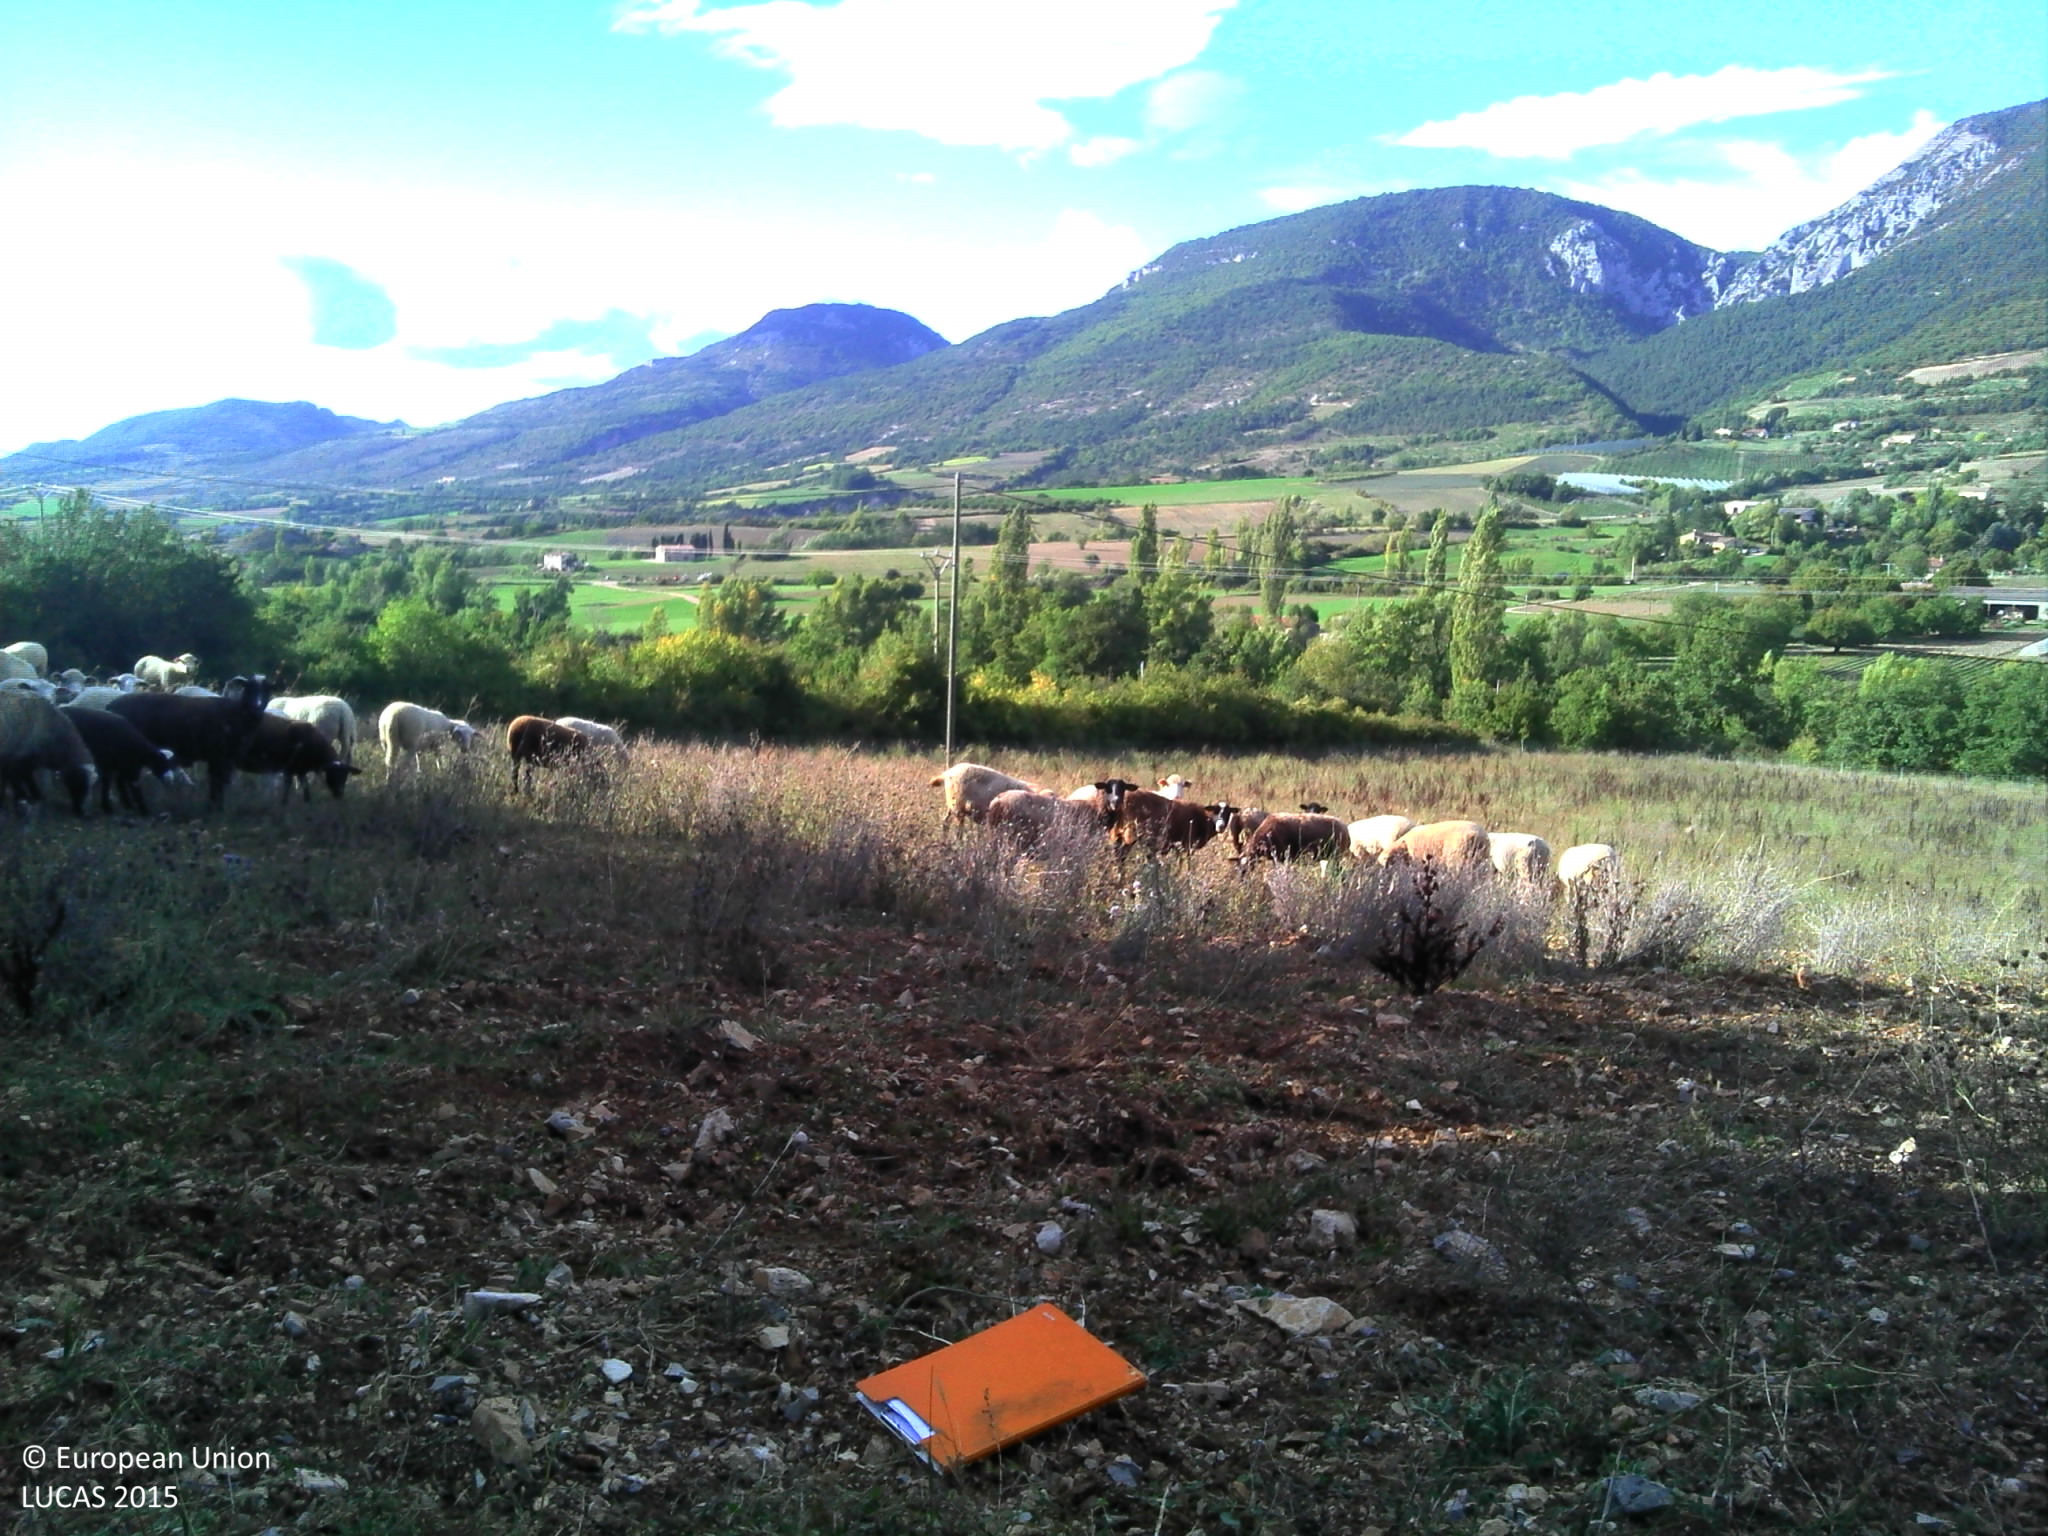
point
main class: Grassland
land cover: Grassland without tree/shrub cover
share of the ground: 50 - 75 %
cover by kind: herbaceous plants 60 %, unconsolidated bare surface 40 %
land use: Agriculture (excluding fallow land and kitchen gardens)
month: September
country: FR
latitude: 44.2862
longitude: 5.4337
